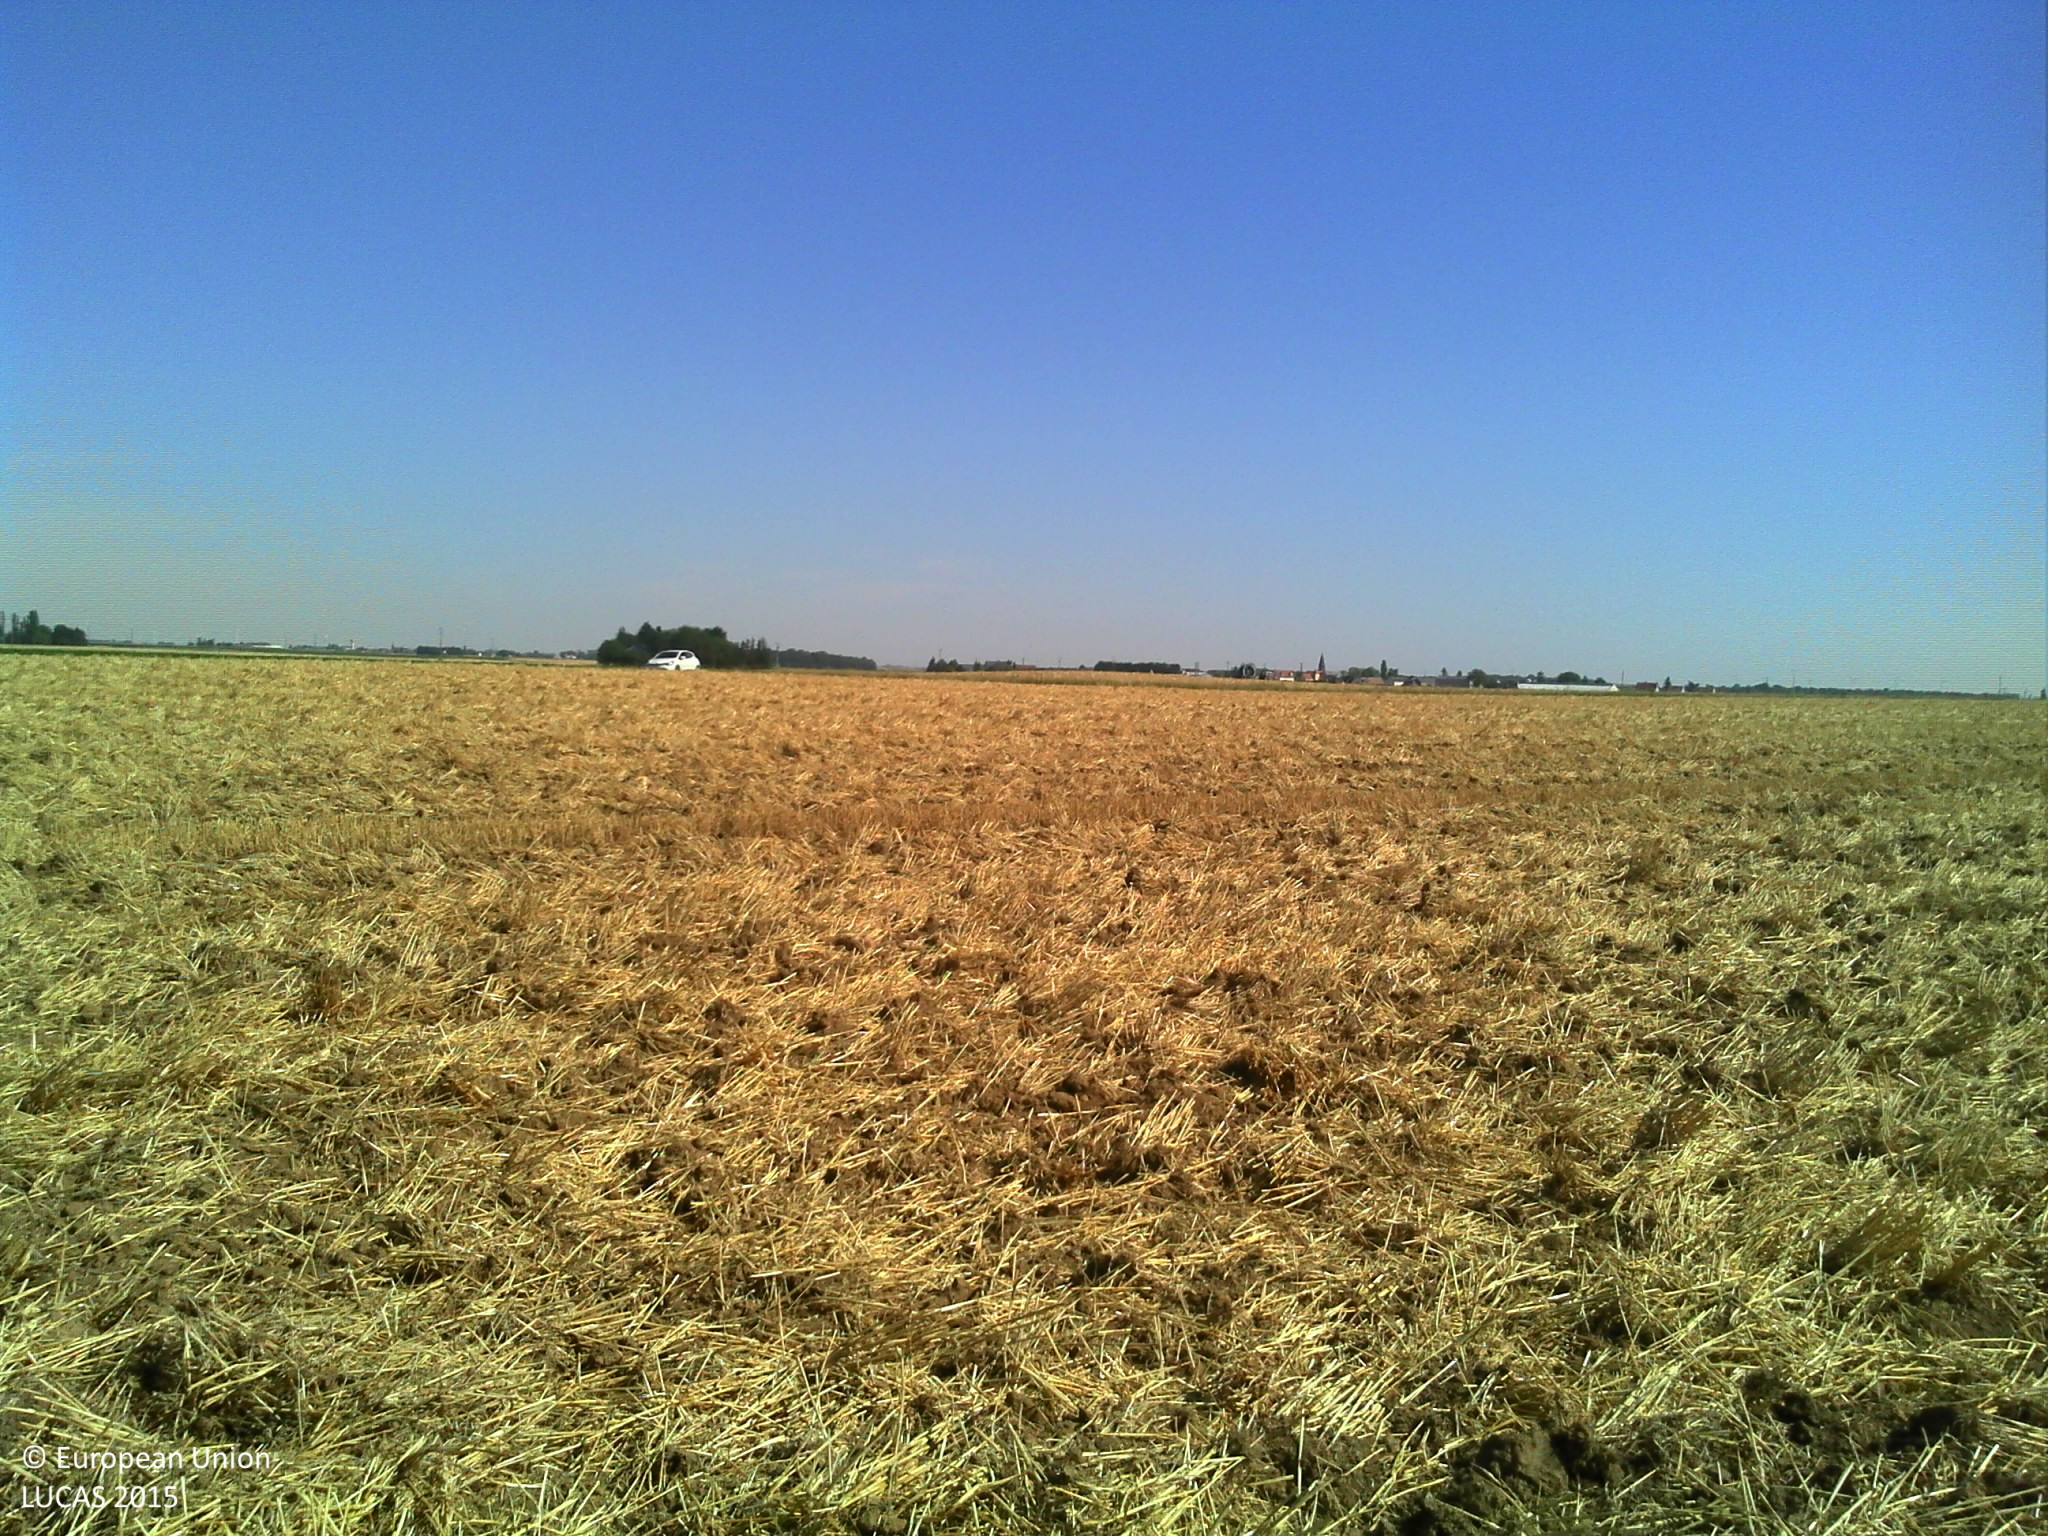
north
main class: Cropland
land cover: Common wheat
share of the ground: > 75 %
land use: Agriculture (excluding fallow land and kitchen gardens)
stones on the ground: < 10 %
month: August
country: FR
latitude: 48.0733
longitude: 1.9477
